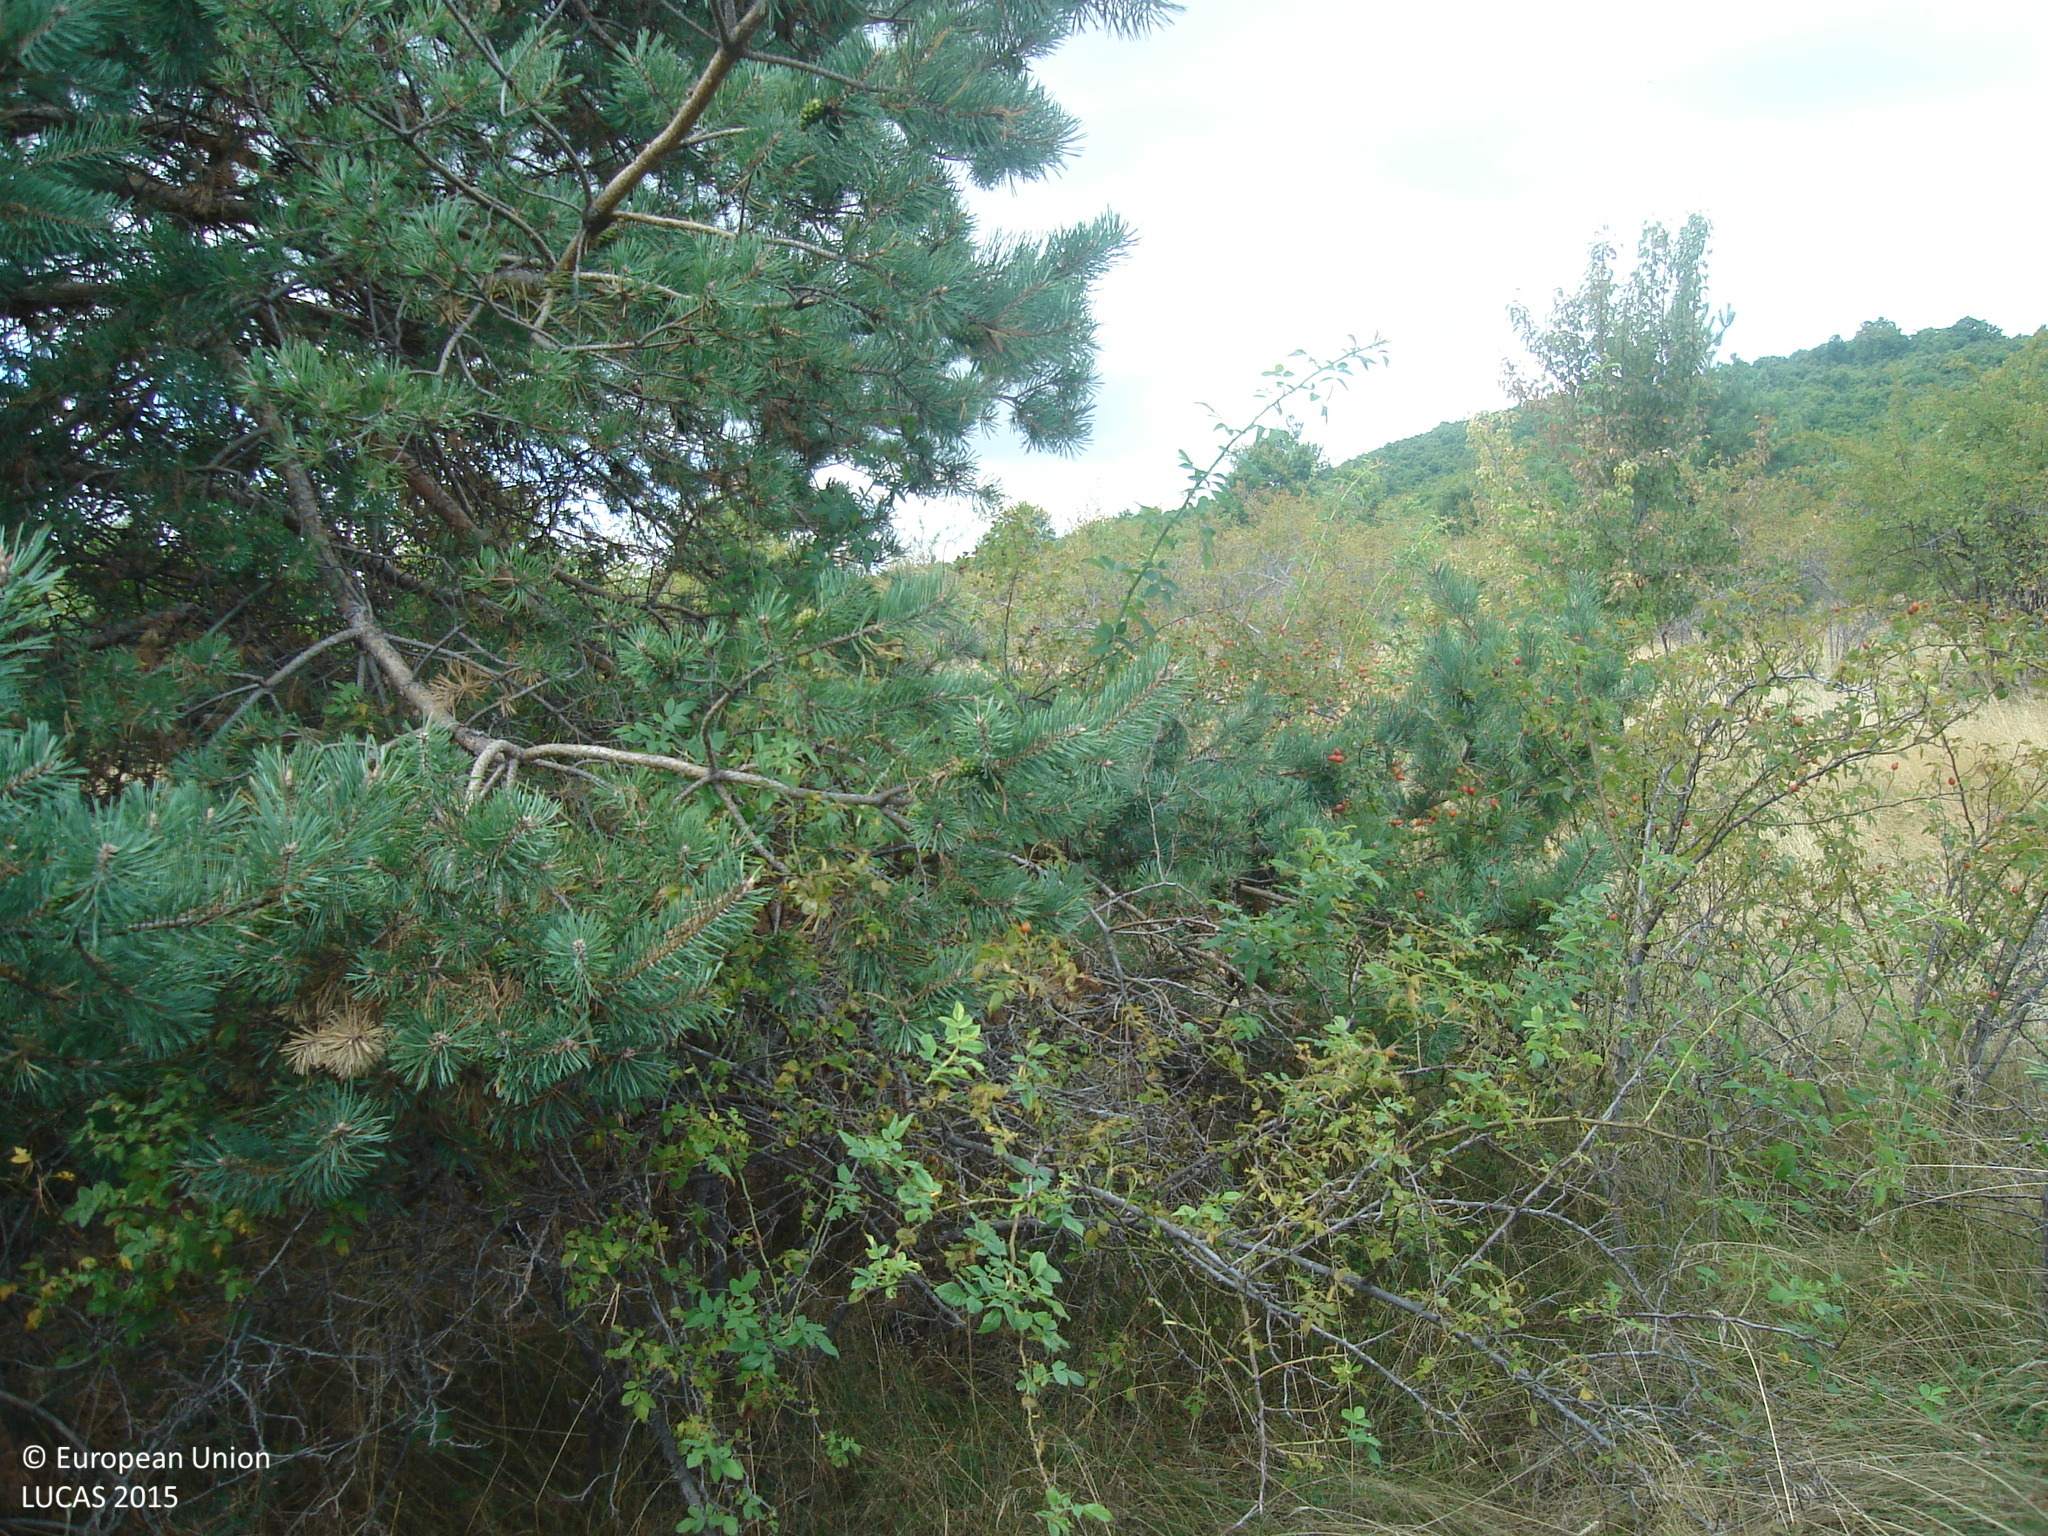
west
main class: Grassland
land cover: Grassland with sparse tree/shrub cover
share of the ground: > 75 %
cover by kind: herbaceous plants 85 %, shrubs 10 %, coniferous forest trees 5 %
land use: Semi-natural and natural areas not in use
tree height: > 5 m
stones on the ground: < 10 %
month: September
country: BG
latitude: 42.4543
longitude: 24.0633
